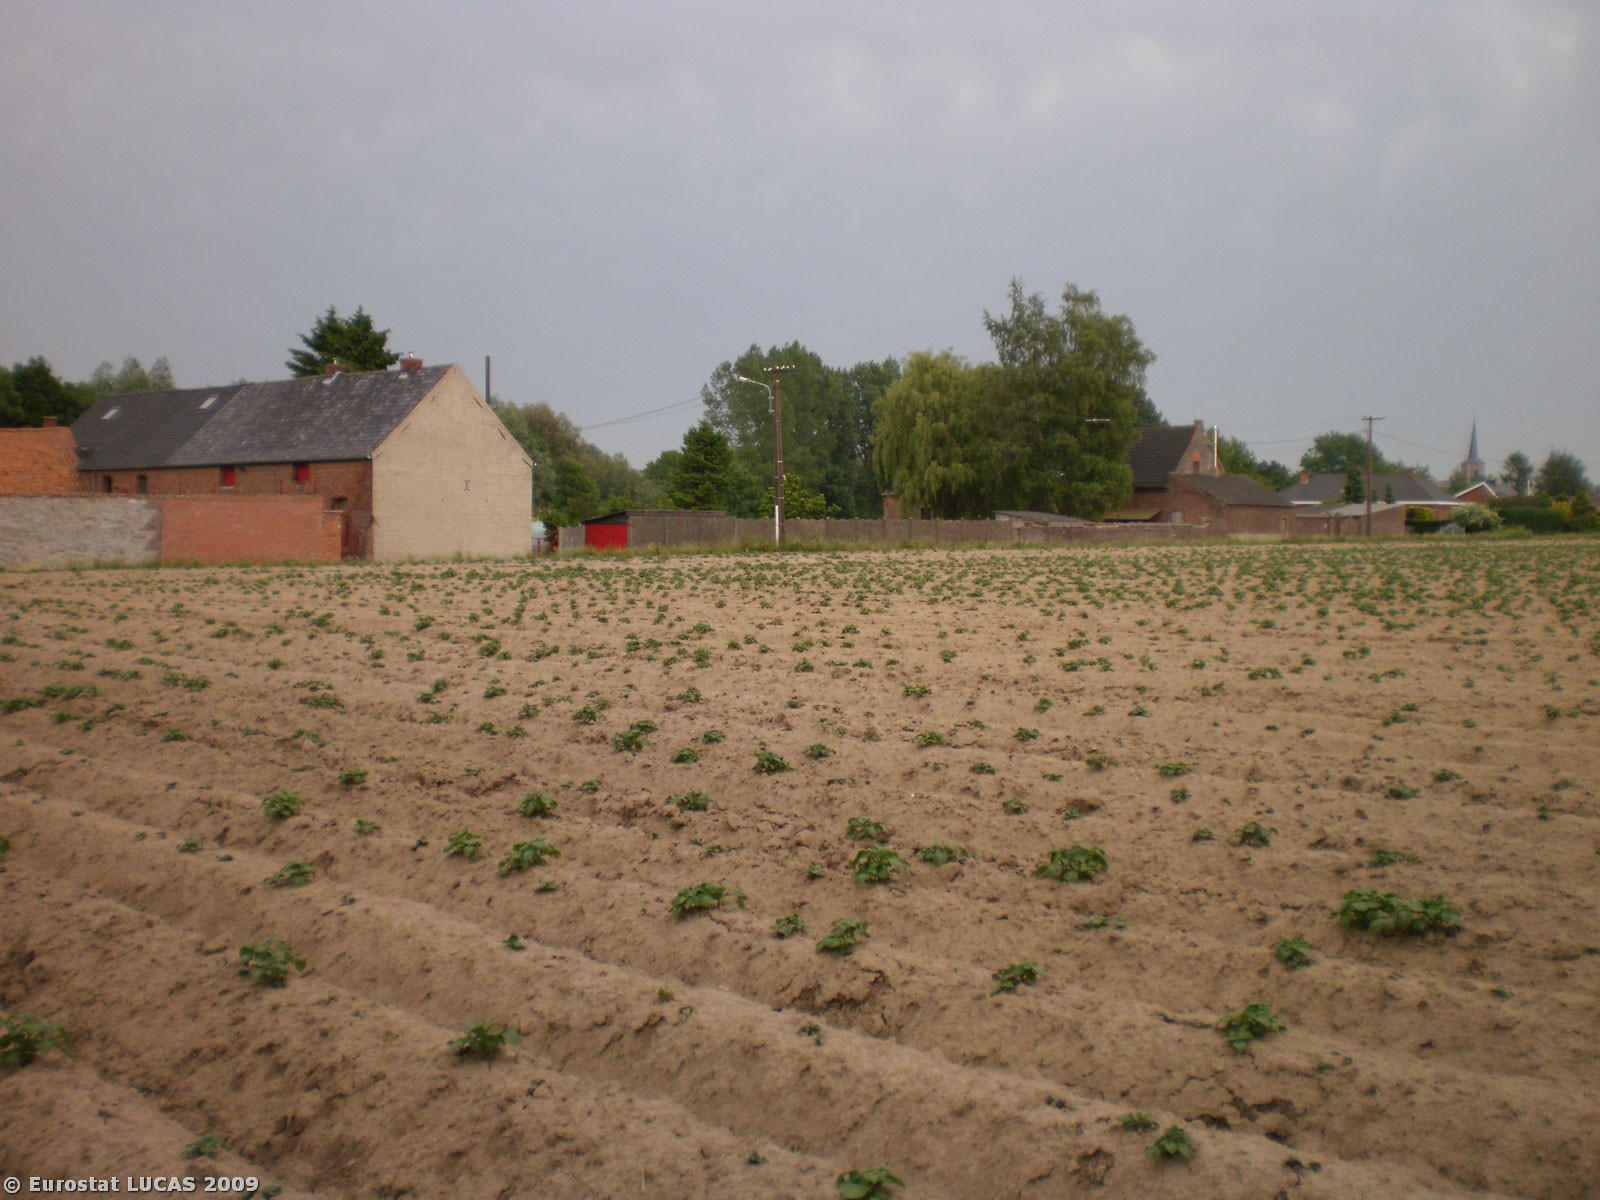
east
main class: Grassland
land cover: Grassland without tree/shrub cover
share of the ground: > 75 %
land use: Agriculture (excluding fallow land and kitchen gardens)
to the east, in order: Grassland without tree/shrub cover; Fences; Managed hedges; Ditches and canals; Grass margins; Potatoes; Ditches and canals; Grass margins; Paved roads, cycling and walking lanes; Artificial constructions in urban areas; Grassland with sparse tree/shrub cover; Managed hedges; Grassland without tree/shrub cover; Managed hedges; Broadleaved woodland; Grassland without tree/shrub cover
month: May
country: BE
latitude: 50.6653
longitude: 3.8108
